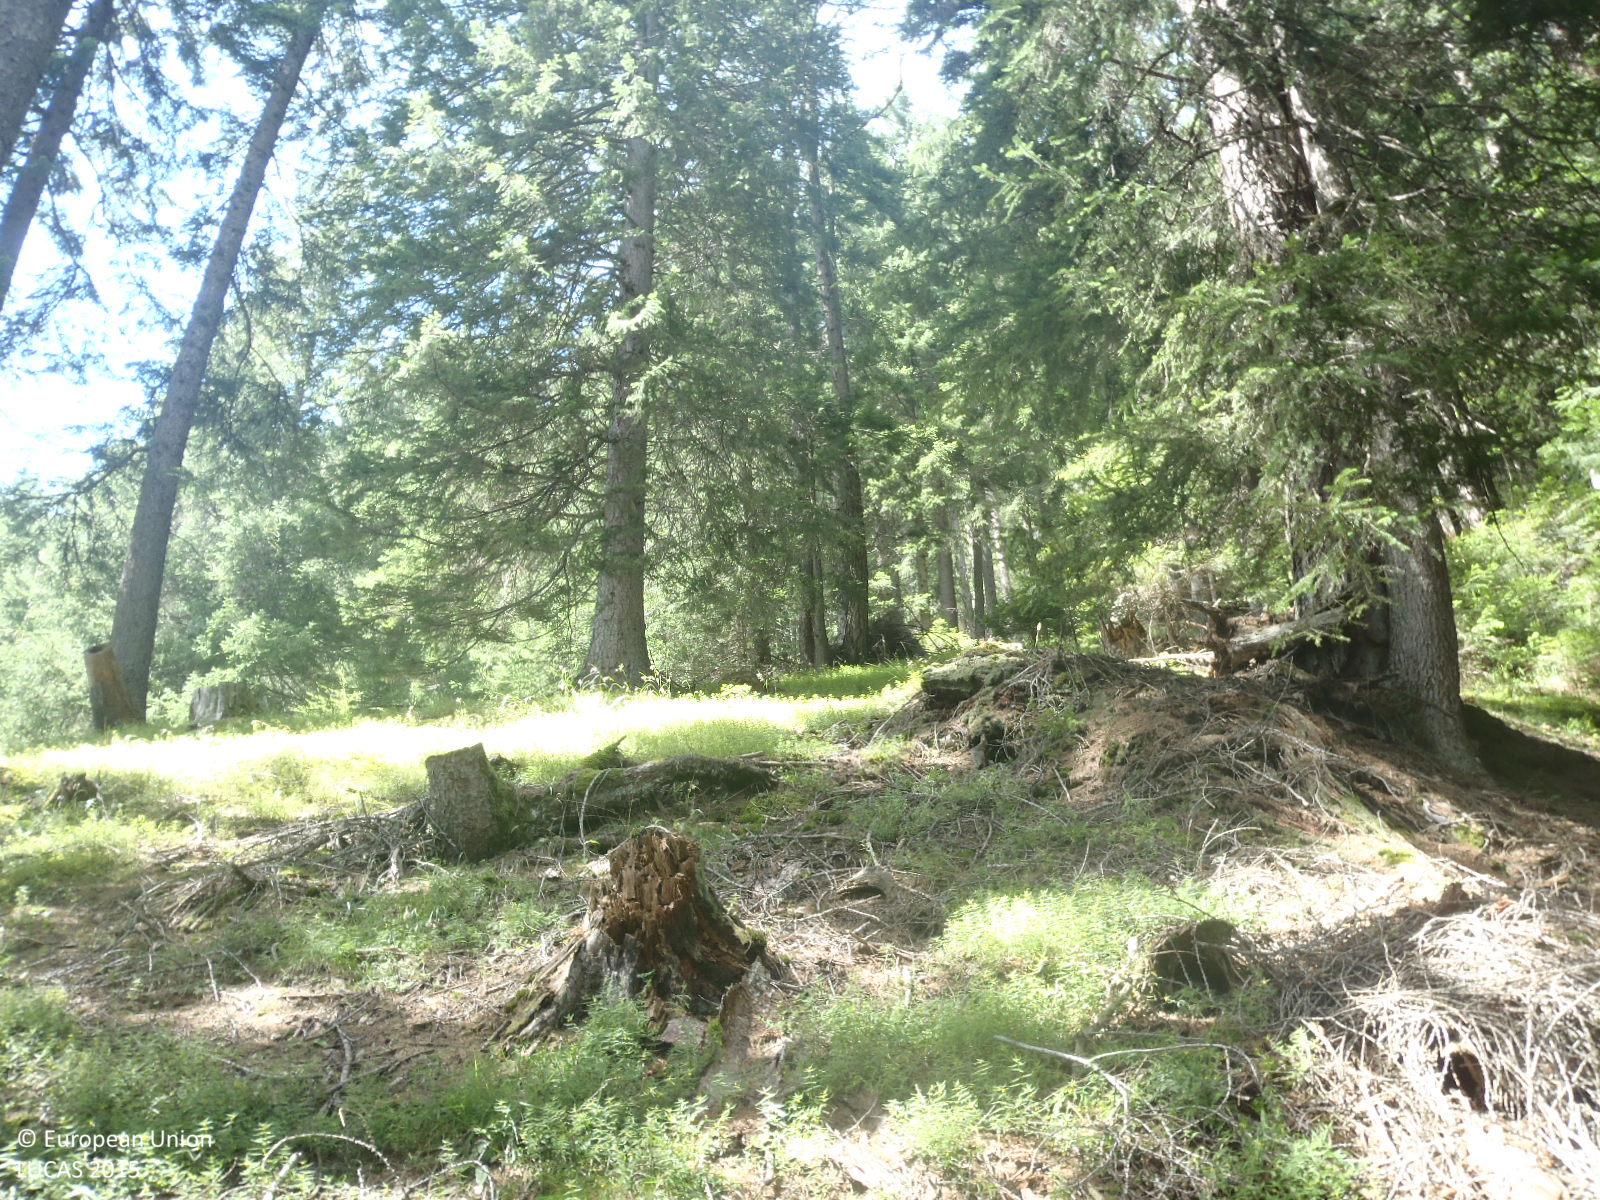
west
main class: Woodland
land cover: Spruce dominated coniferous woodland
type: alpine coniferous forest
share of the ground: > 75 %
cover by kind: coniferous forest trees 90 %, herbaceous plants 10 %
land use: Forestry
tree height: > 5 m
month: August
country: AT
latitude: 47.0064
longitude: 12.5100
